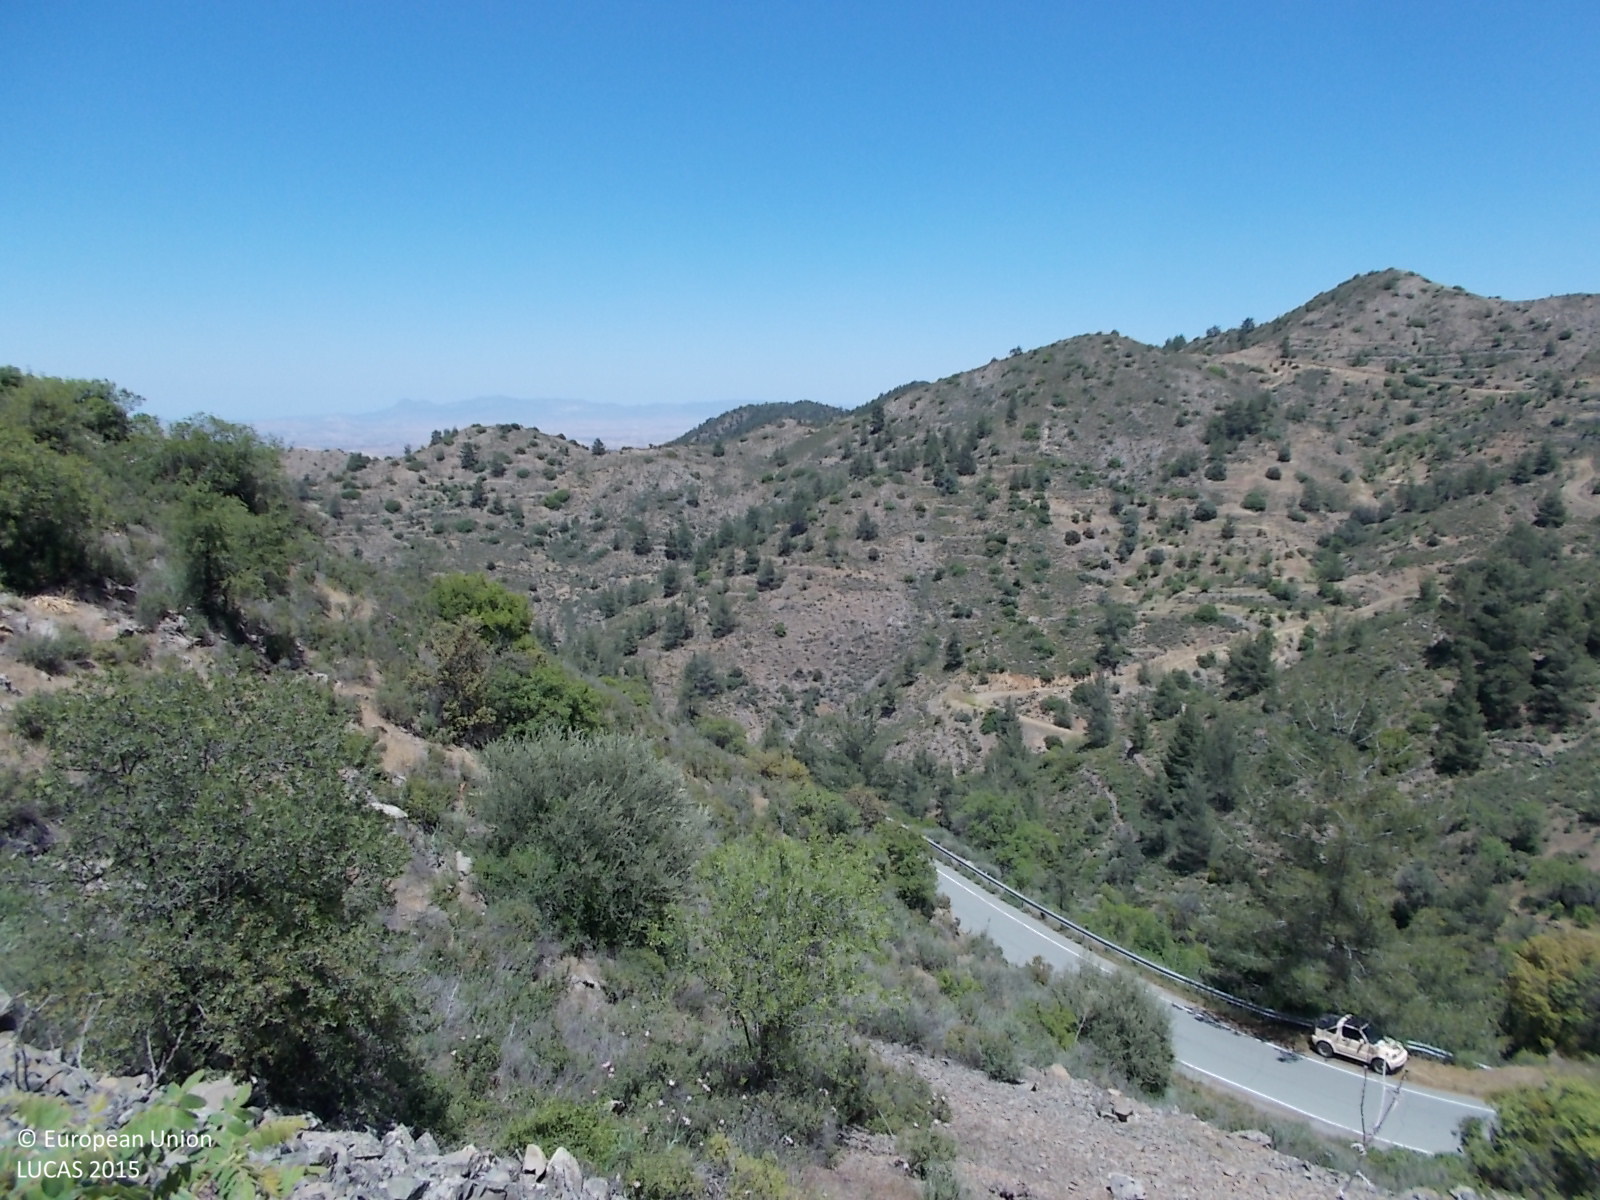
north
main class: Woodland
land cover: Other mixed woodland
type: broadleaved evergreen forest
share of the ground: 10 - 25 %
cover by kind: shrubs 30 %, herbaceous plants 30 %, unconsolidated bare surface 20 %, broadleaved forest trees 10 %, coniferous forest trees 5 %, consolidated bare surface 5 %
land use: Forestry
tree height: > 5 m
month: May
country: CY
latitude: 34.9579
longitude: 33.1654
